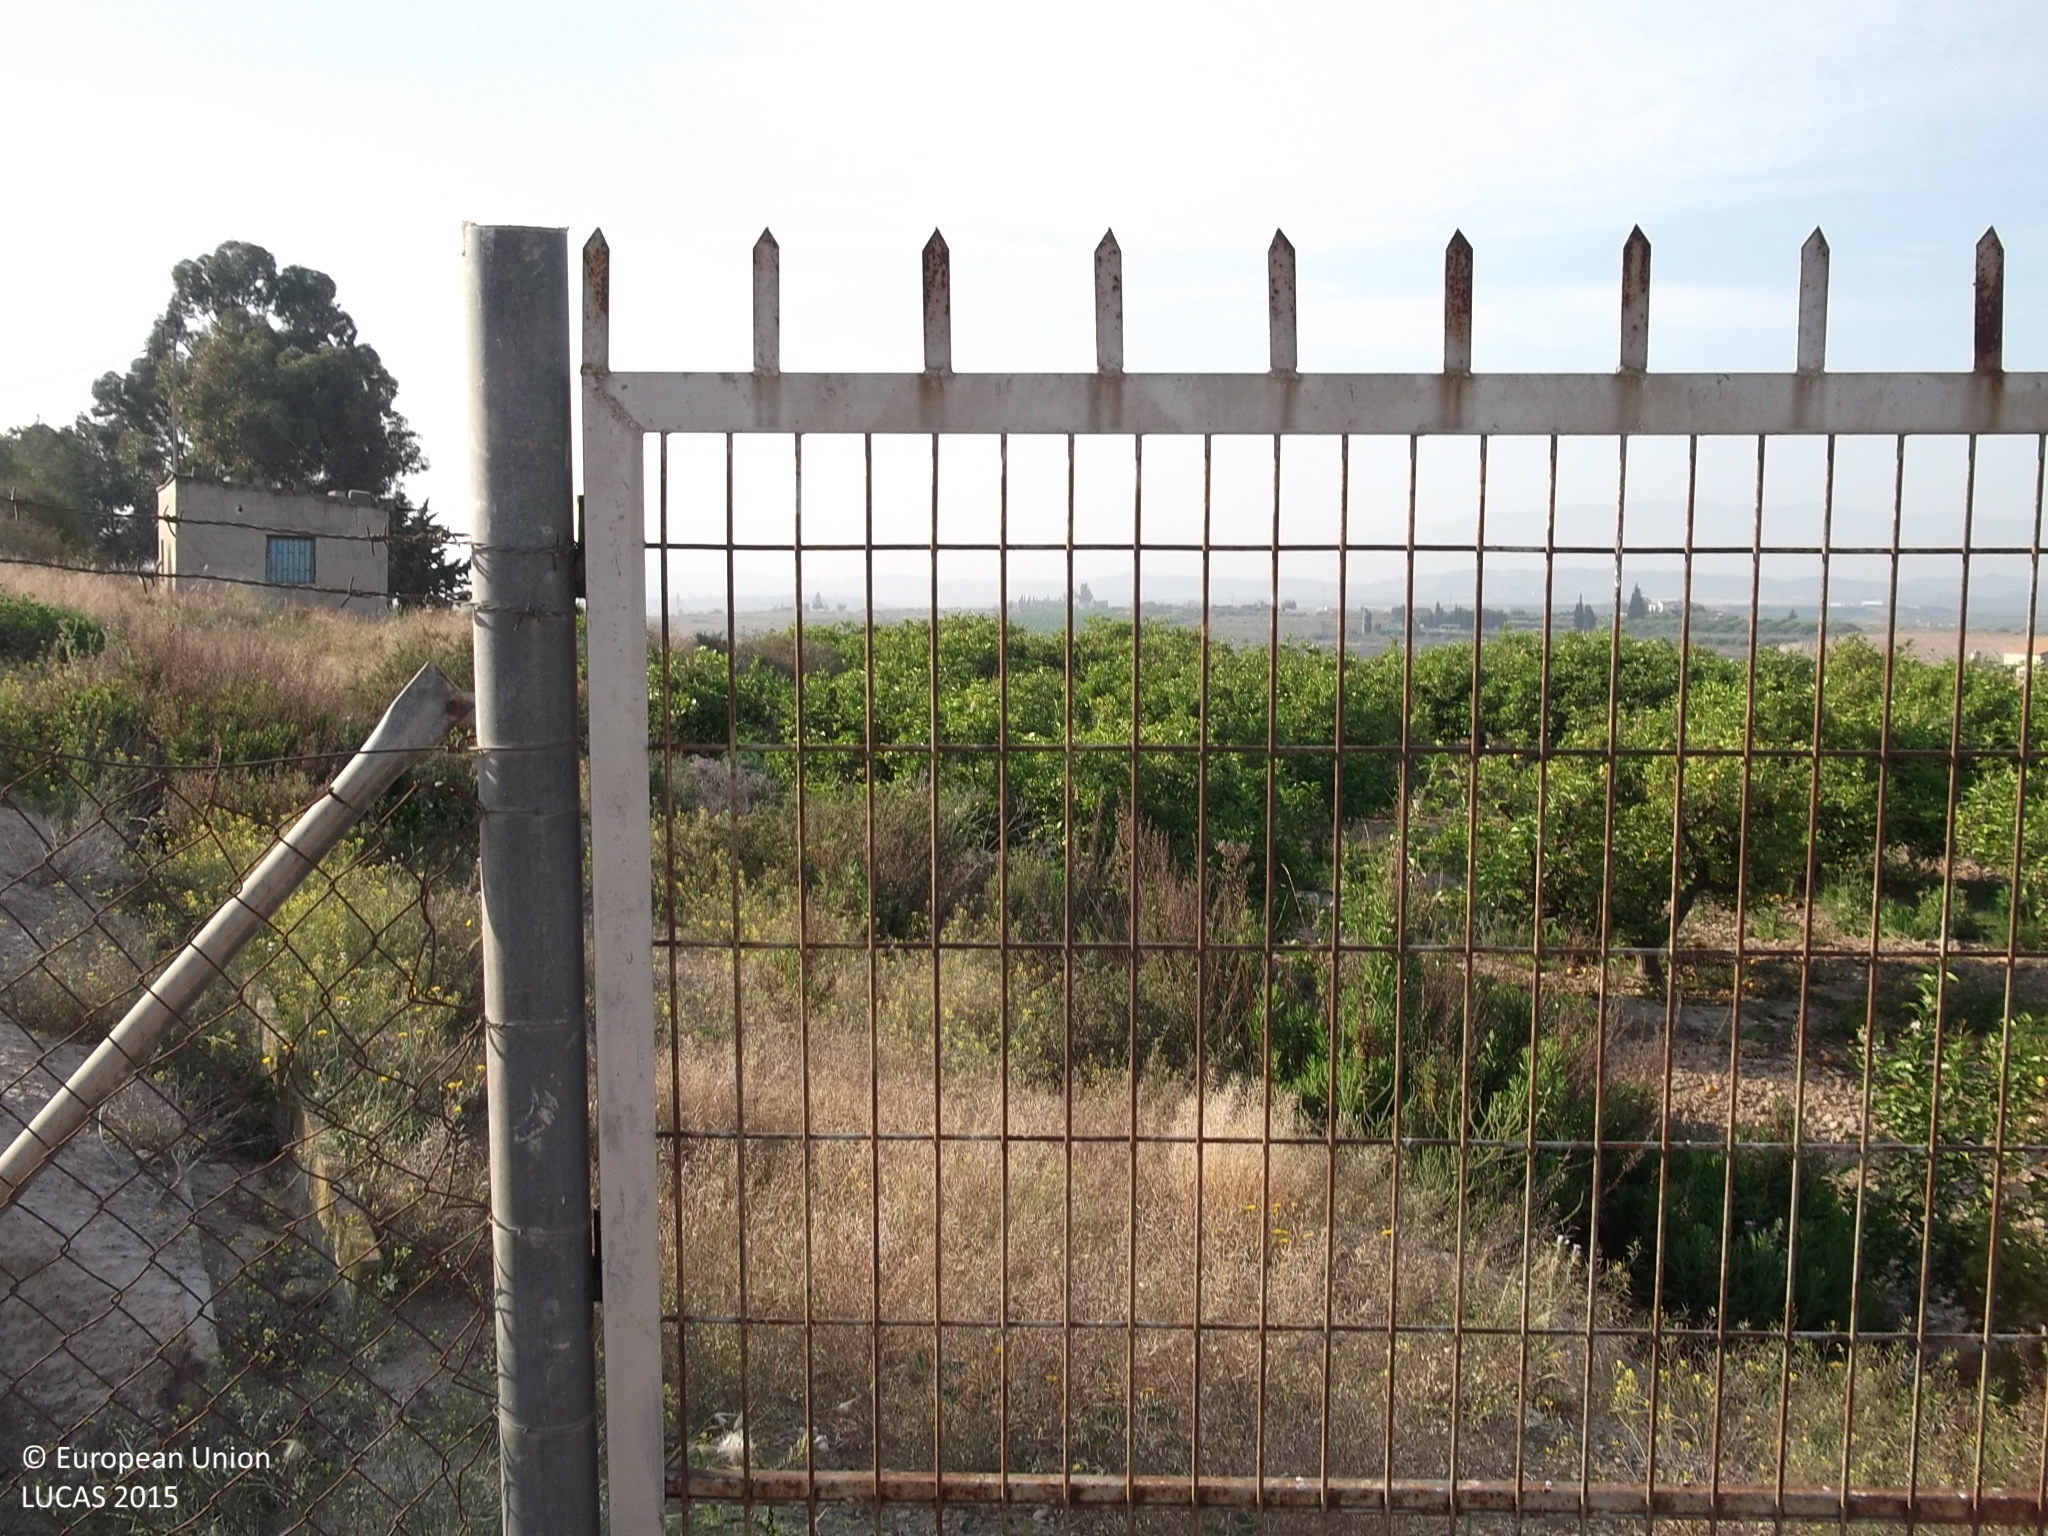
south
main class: Cropland
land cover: Other citrus fruit
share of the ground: 25 - 50 %
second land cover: Other bare soil
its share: > 75 %
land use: Agriculture (excluding fallow land and kitchen gardens)
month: April
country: ES
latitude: 38.0232
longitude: -1.2969
